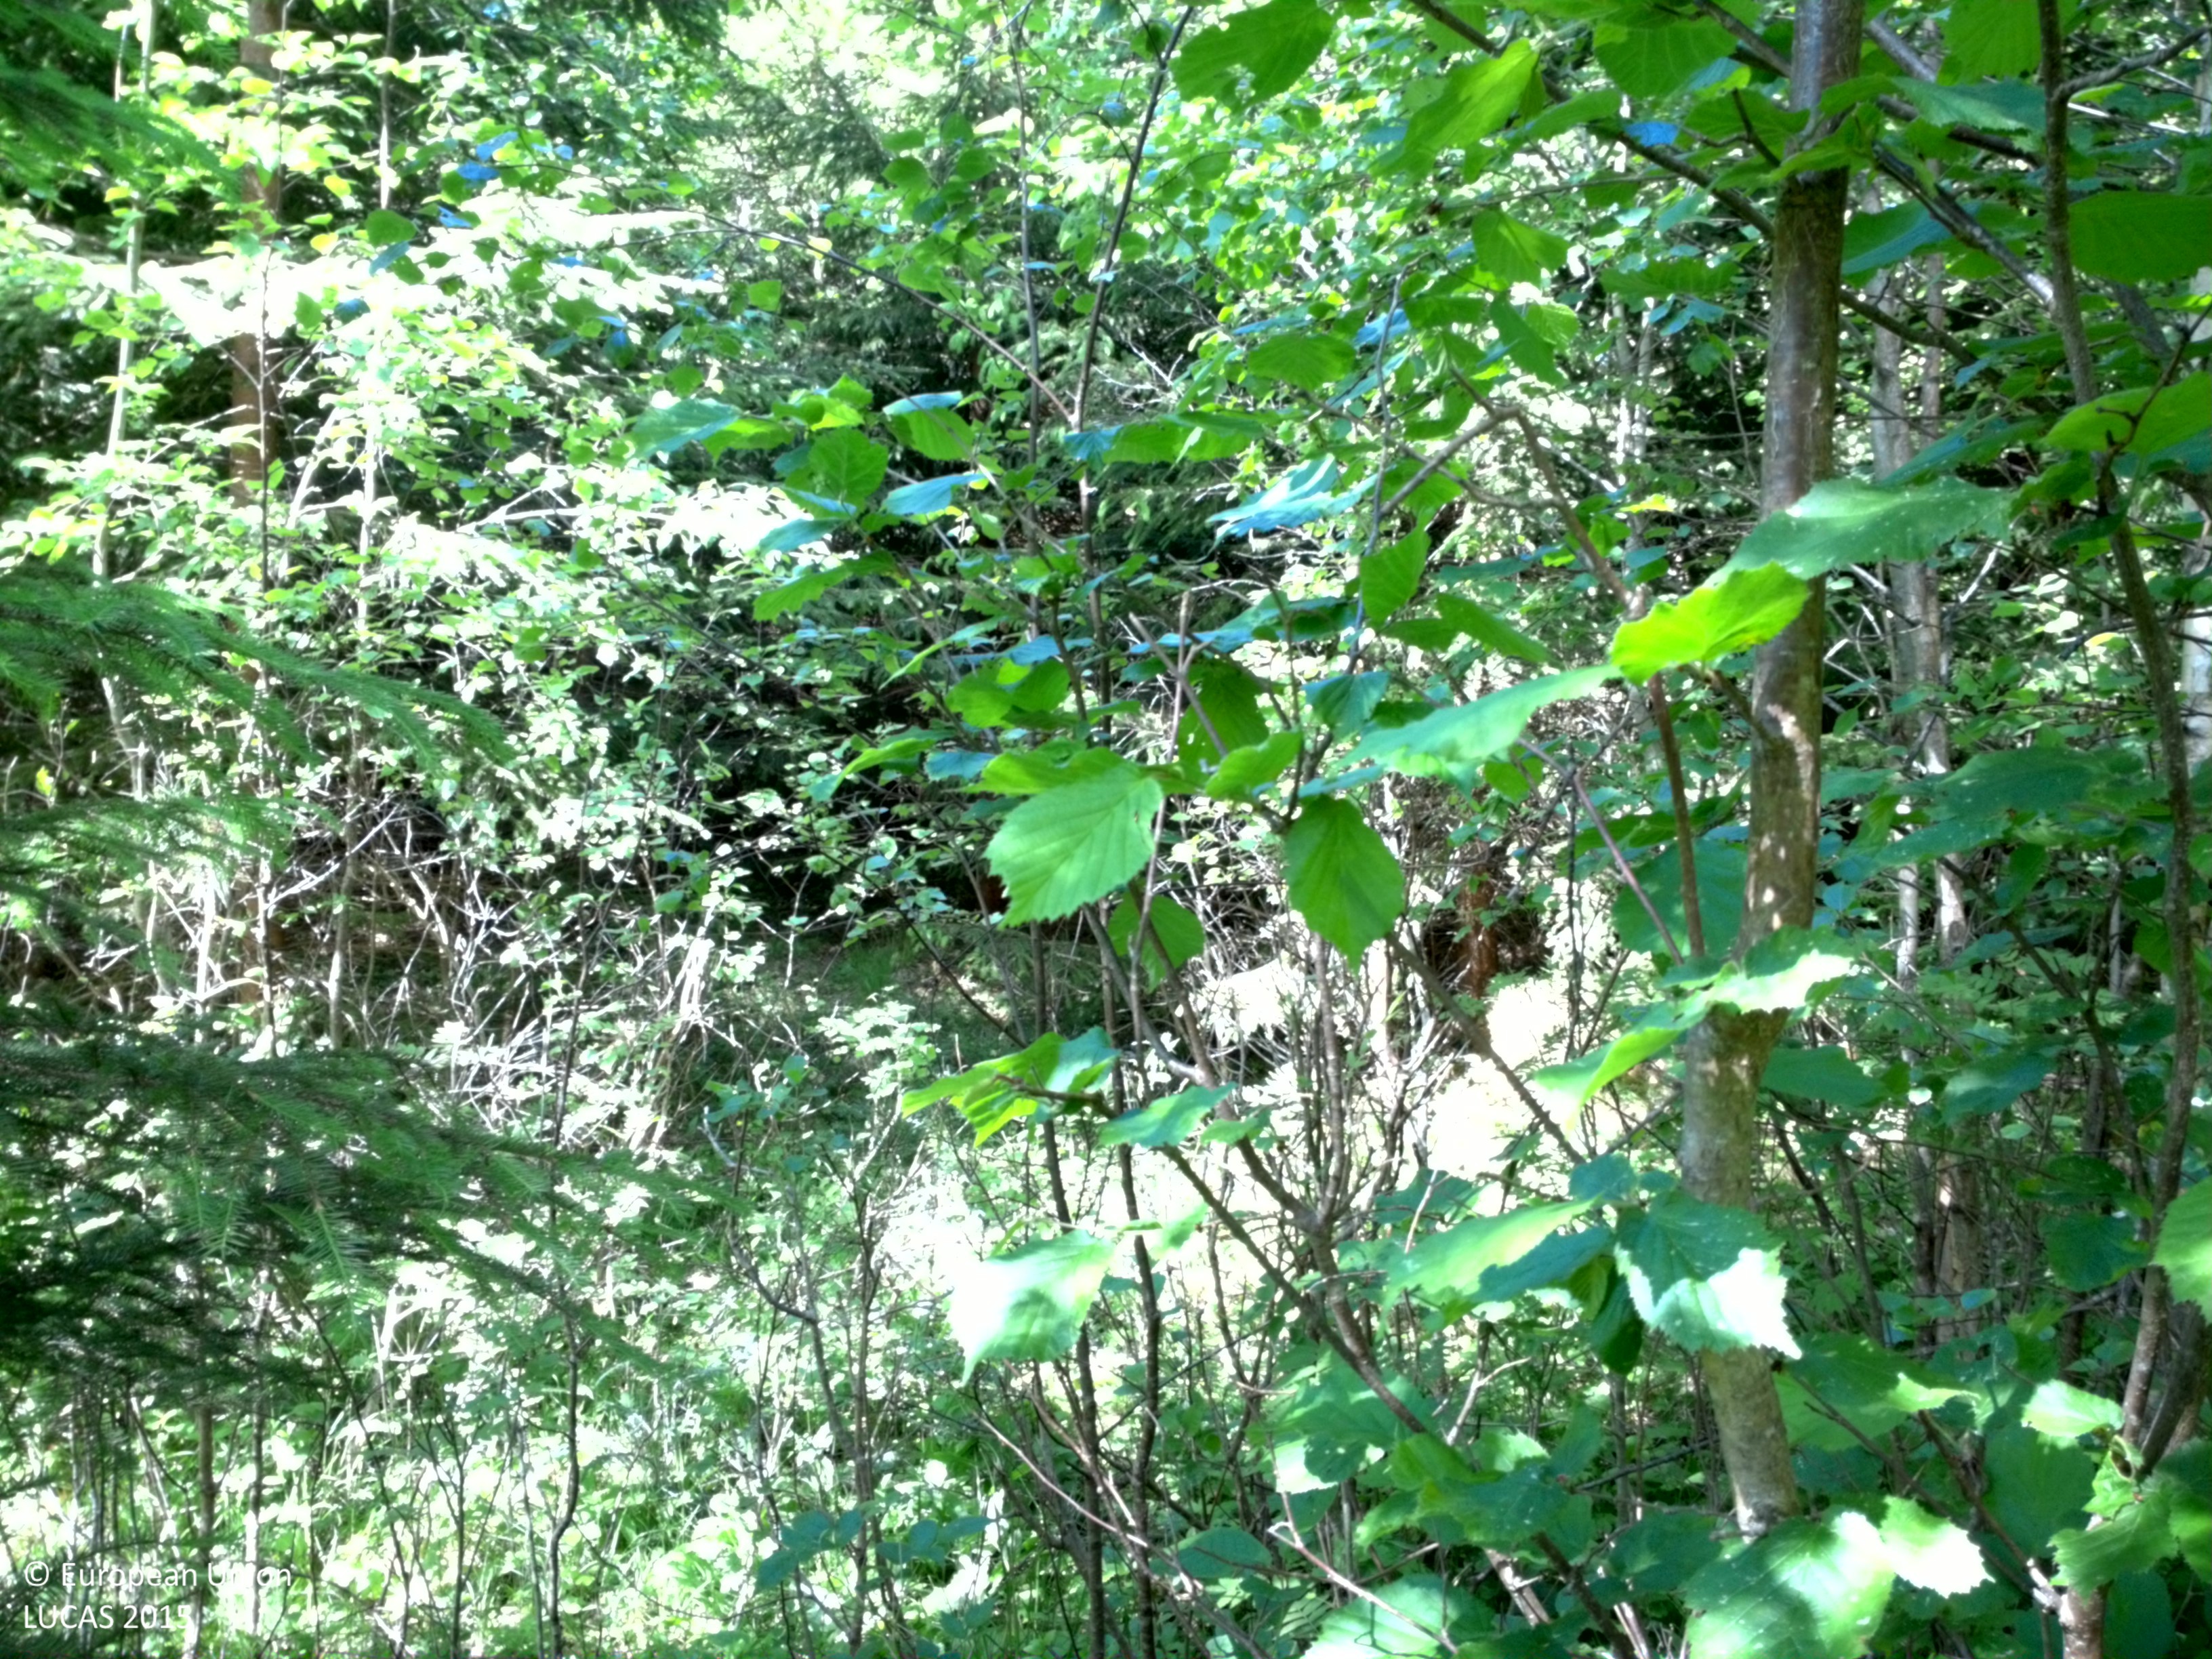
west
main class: Woodland
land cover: Broadleaved woodland
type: boreal forest
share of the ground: > 75 %
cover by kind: broadleaved forest trees 80 %, coniferous forest trees 10 %, herbaceous plants 10 %
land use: Forestry
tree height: > 5 m
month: June
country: SE
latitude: 58.6311
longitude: 14.4885
